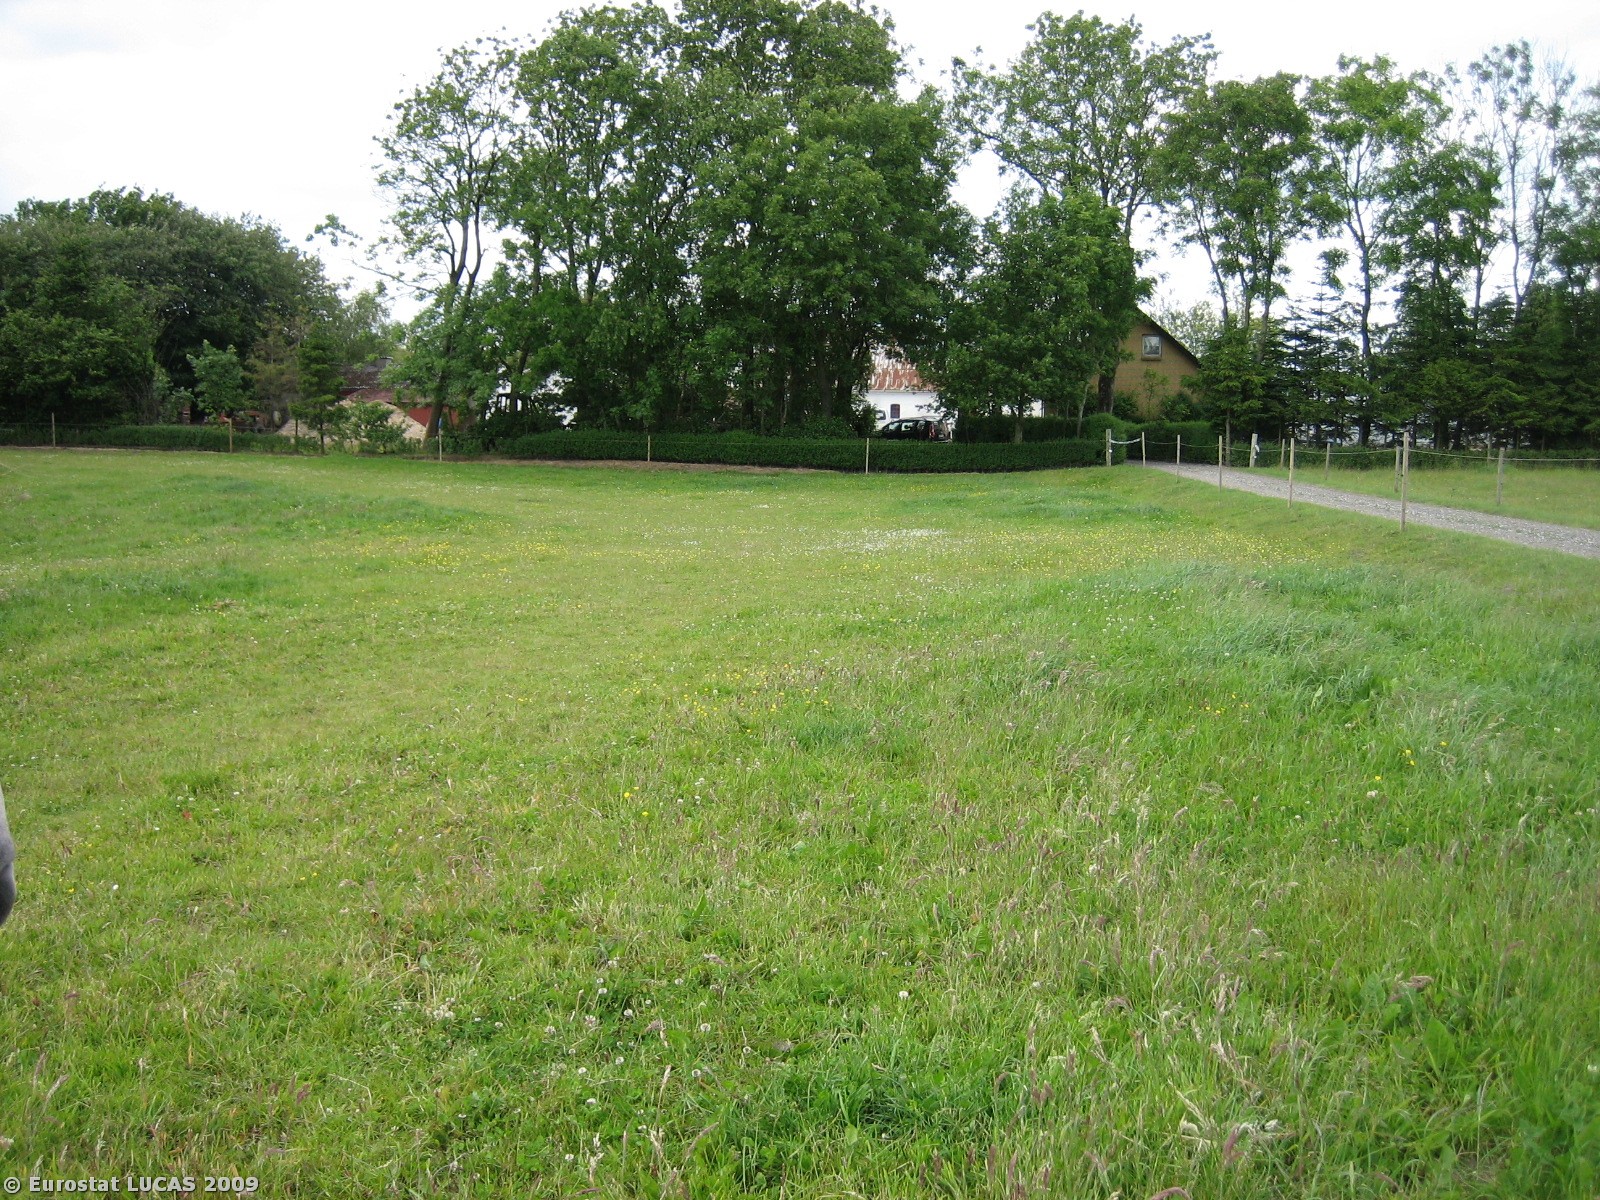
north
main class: Grassland
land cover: Grassland without tree/shrub cover
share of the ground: > 75 %
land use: Agriculture (excluding fallow land and kitchen gardens)
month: June
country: DK
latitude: 55.6285
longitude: 9.2860
